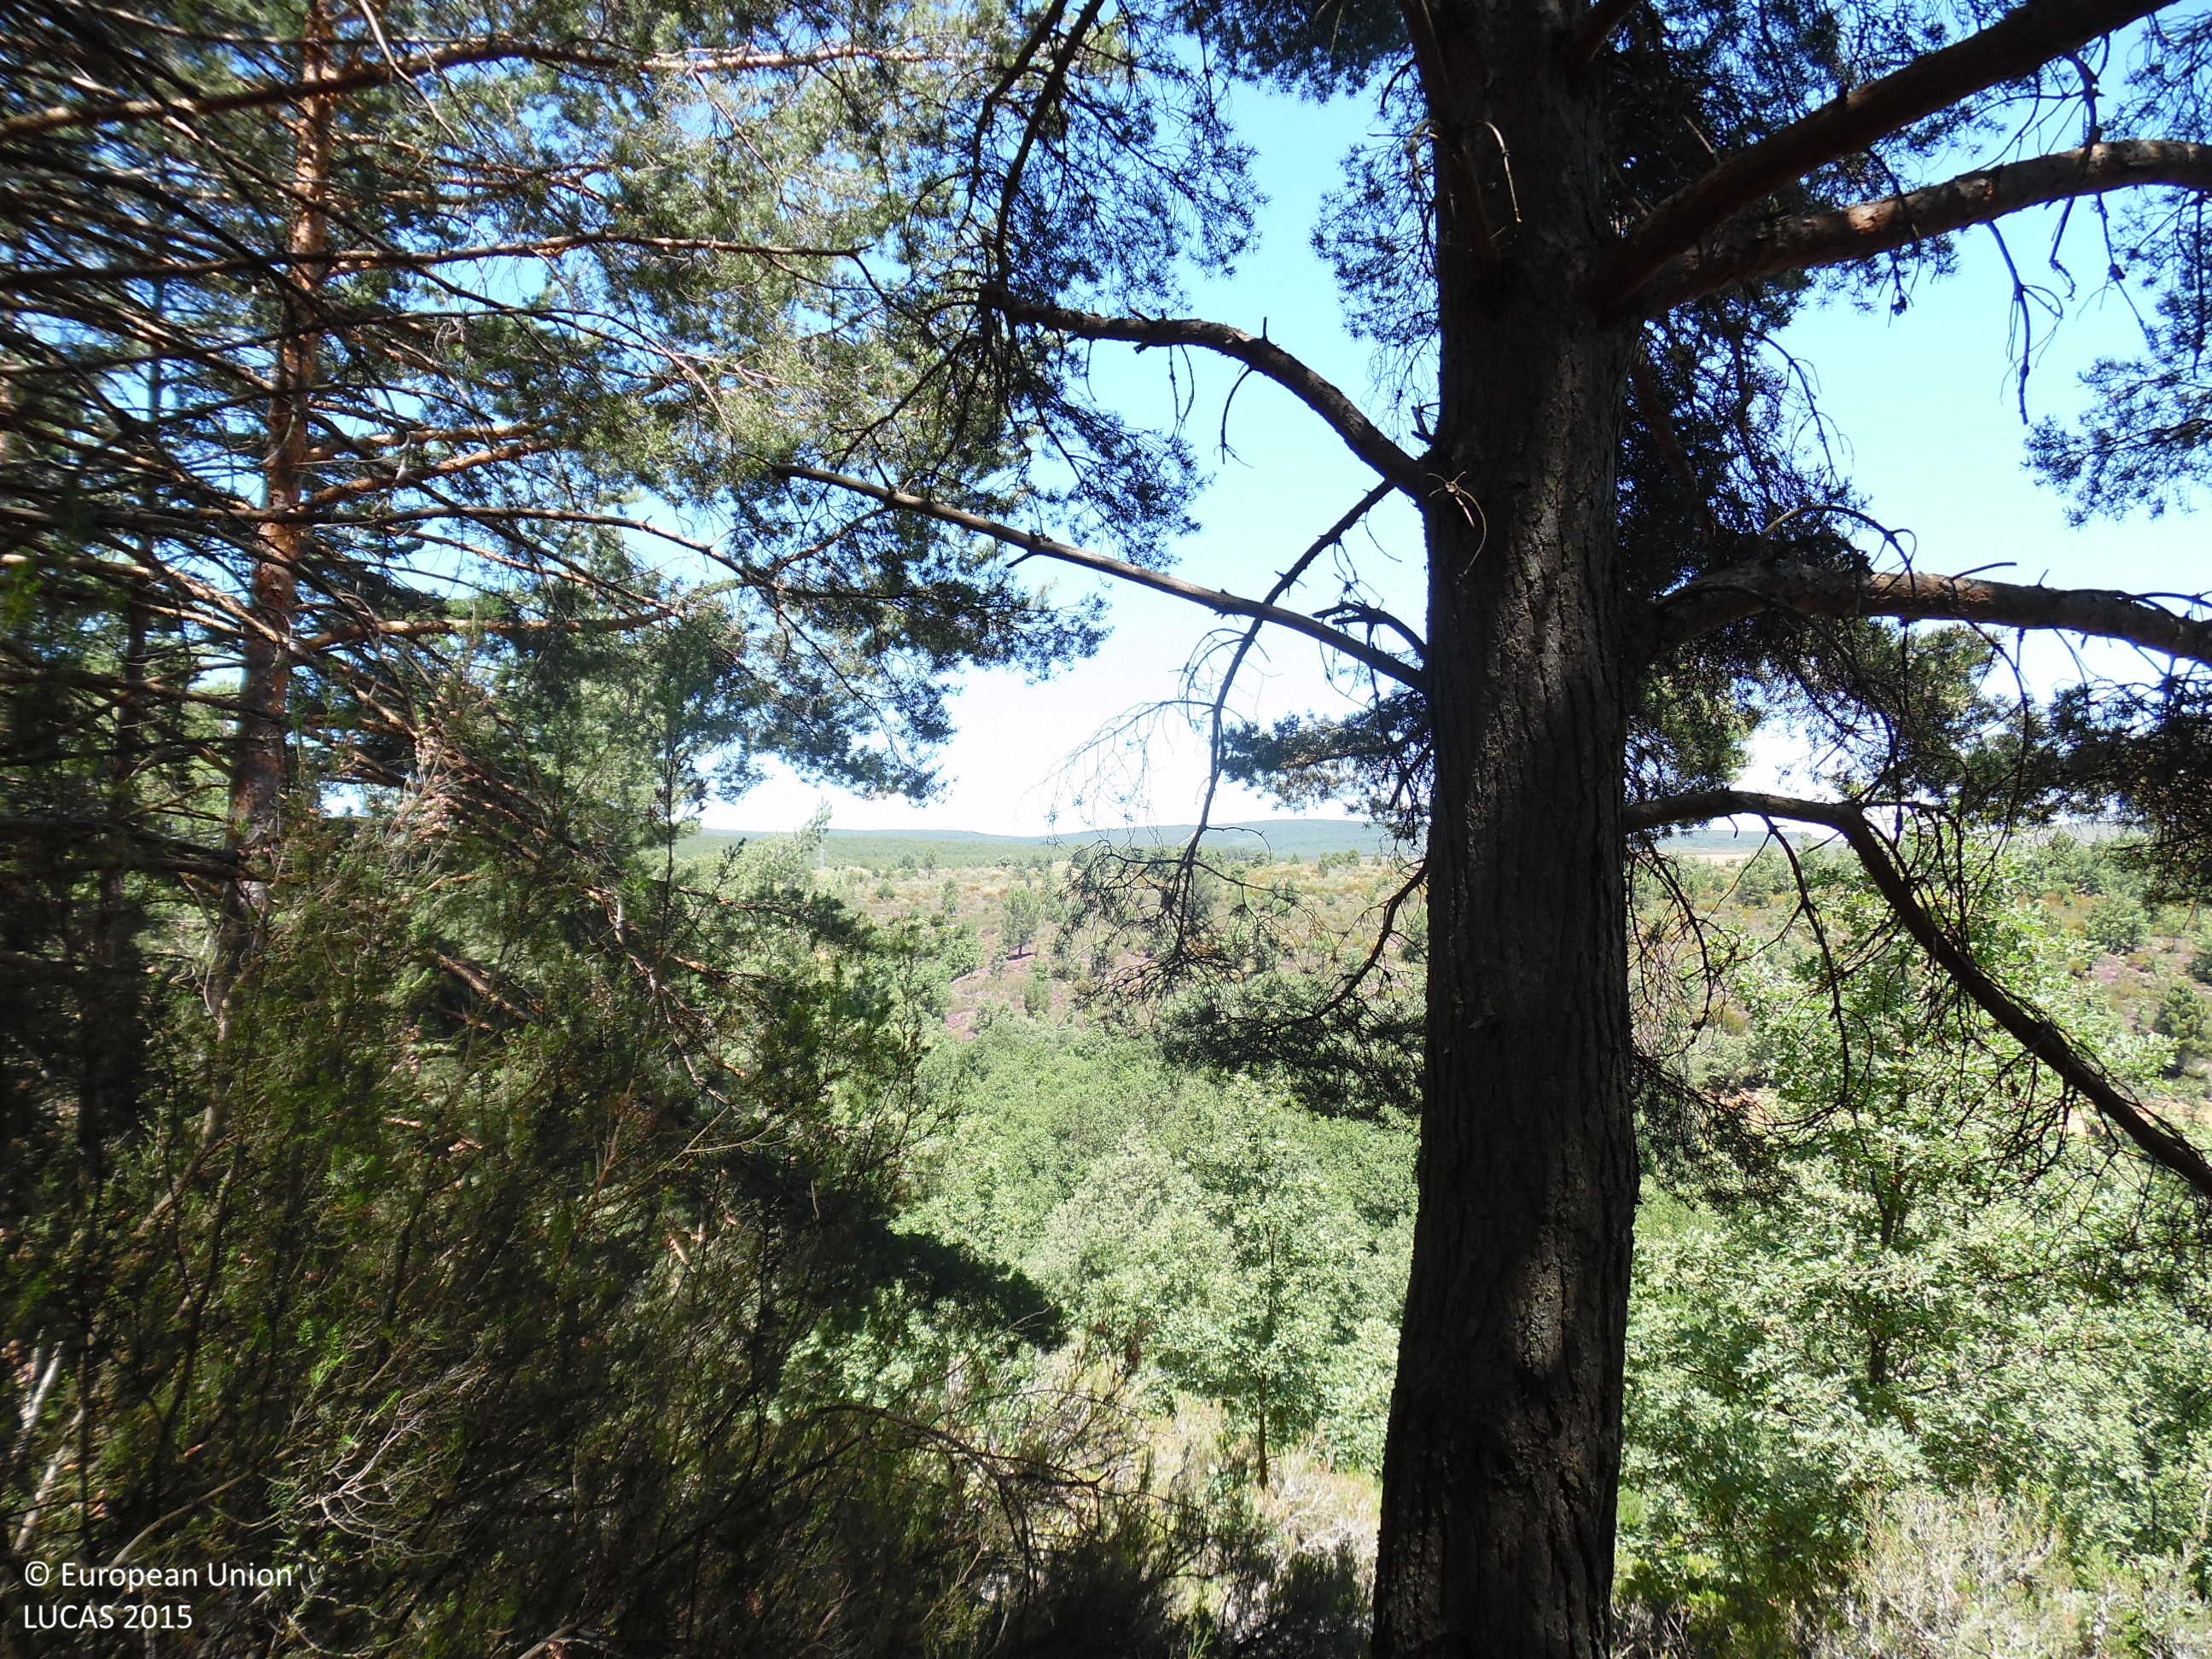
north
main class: Woodland
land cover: Pine dominated coniferous woodland
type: coniferous forest of the mediterranean region
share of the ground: 50 - 75 %
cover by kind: coniferous forest trees 95 %, shrubs 5 %
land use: Forestry
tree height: > 5 m
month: June
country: ES
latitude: 42.5433
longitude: -6.1460
